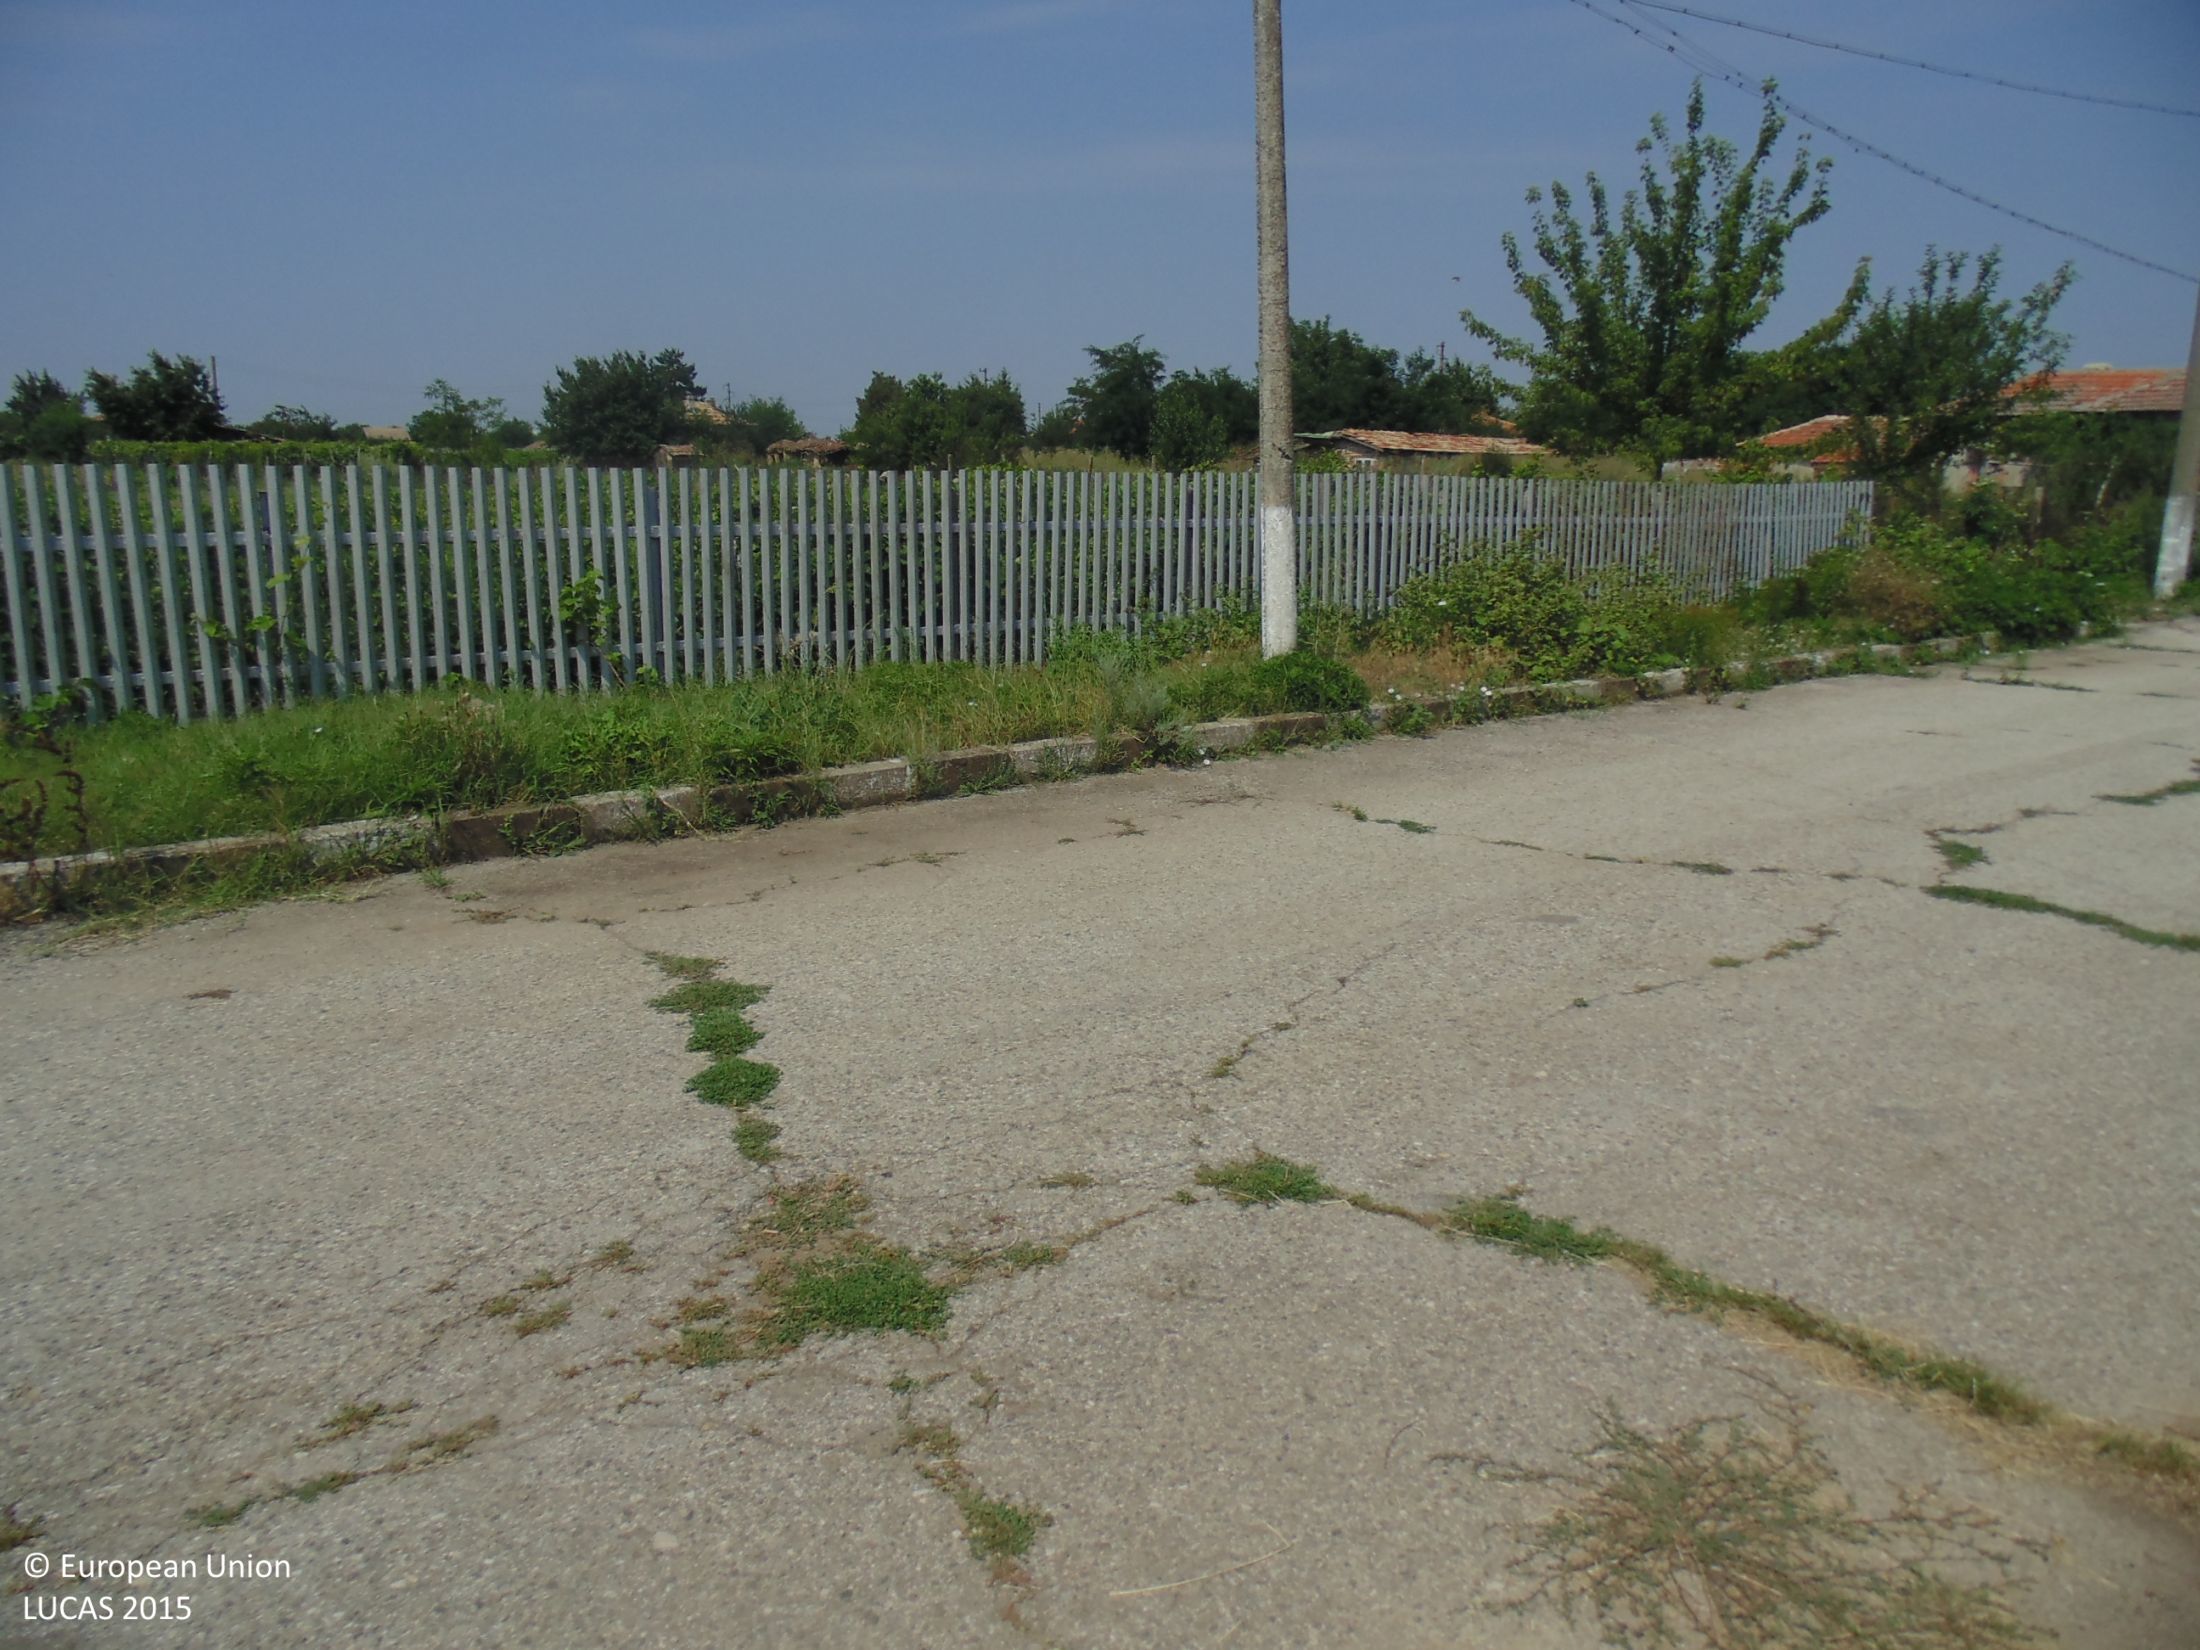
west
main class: Cropland
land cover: Other fruit trees and berries
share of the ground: 25 - 50 %
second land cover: Grassland without tree/shrub cover
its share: > 75 %
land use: Kitchen garden
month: July
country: BG
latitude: 43.6132
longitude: 27.9765
